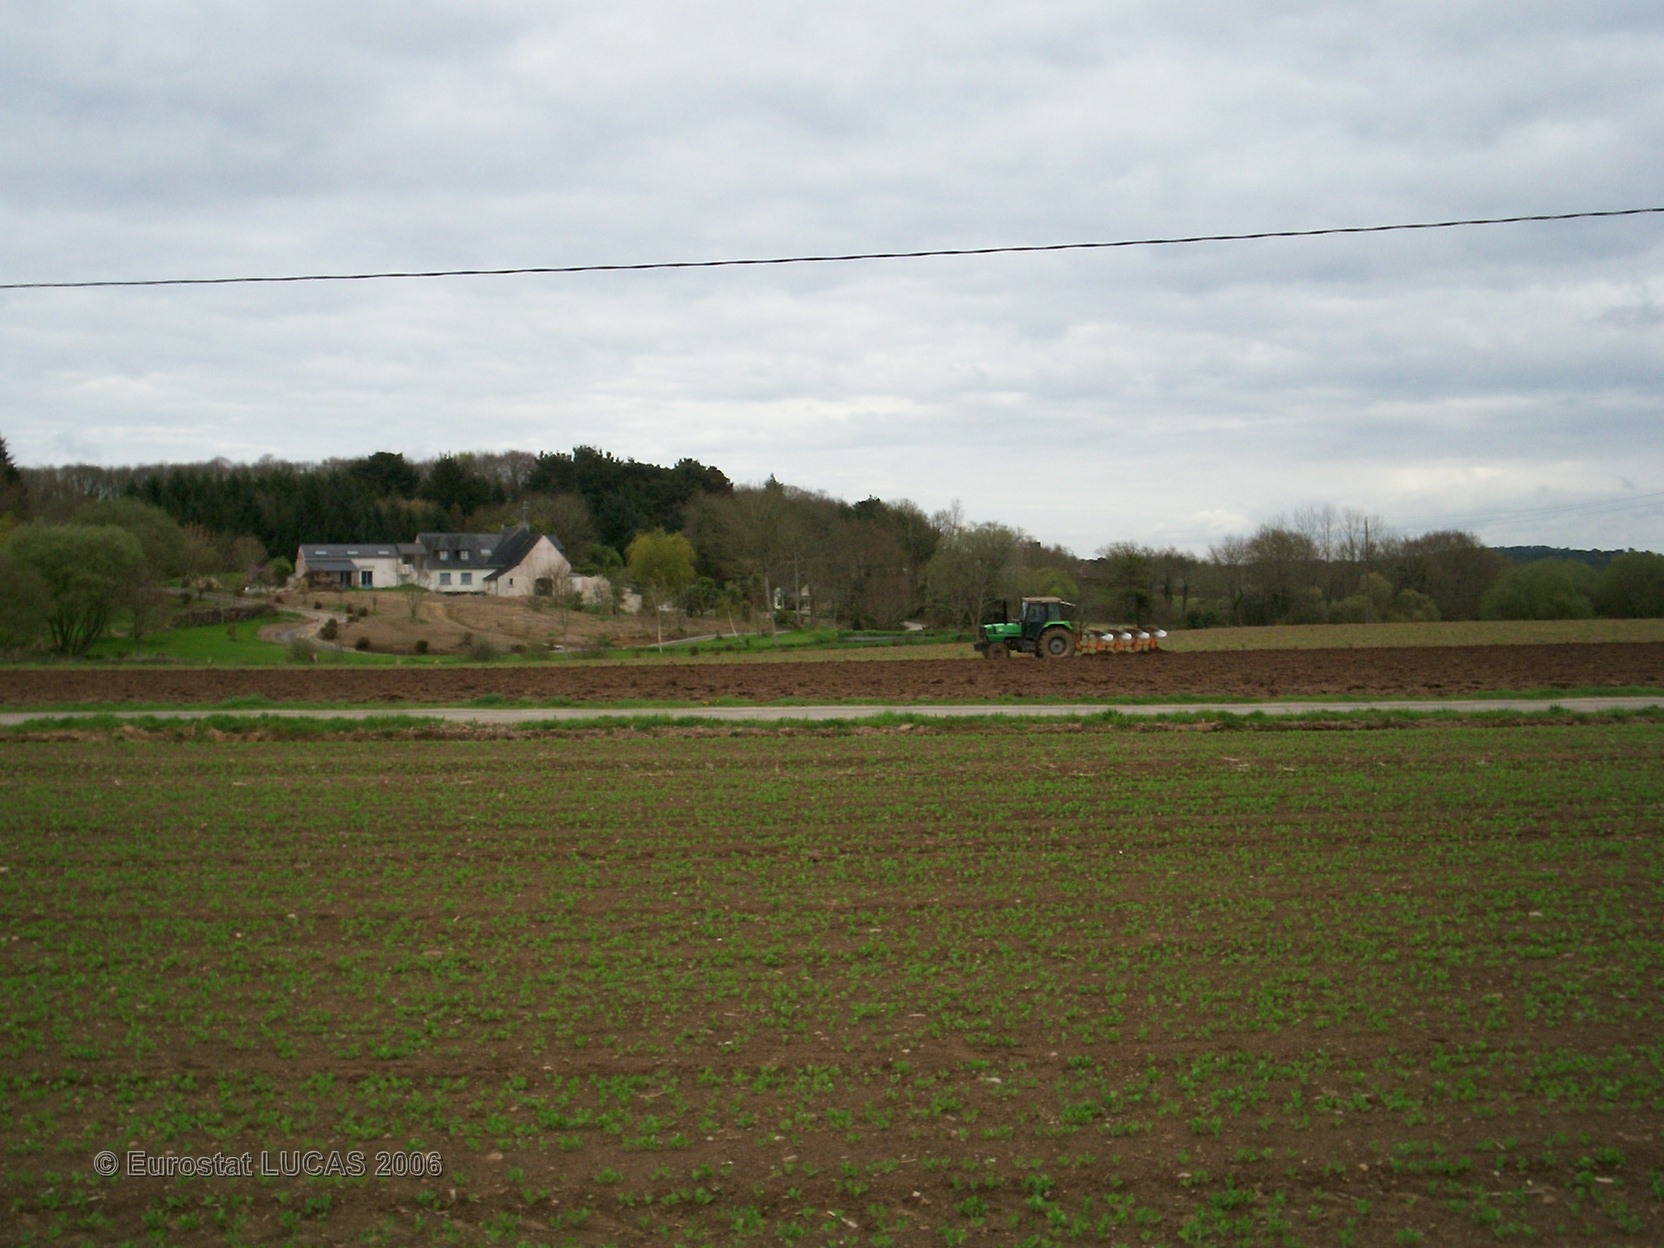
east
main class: Cropland
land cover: Dry pulses
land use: Agriculture (excluding fallow land and kitchen gardens)
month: April
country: FR
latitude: 47.8229
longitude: -3.5267
